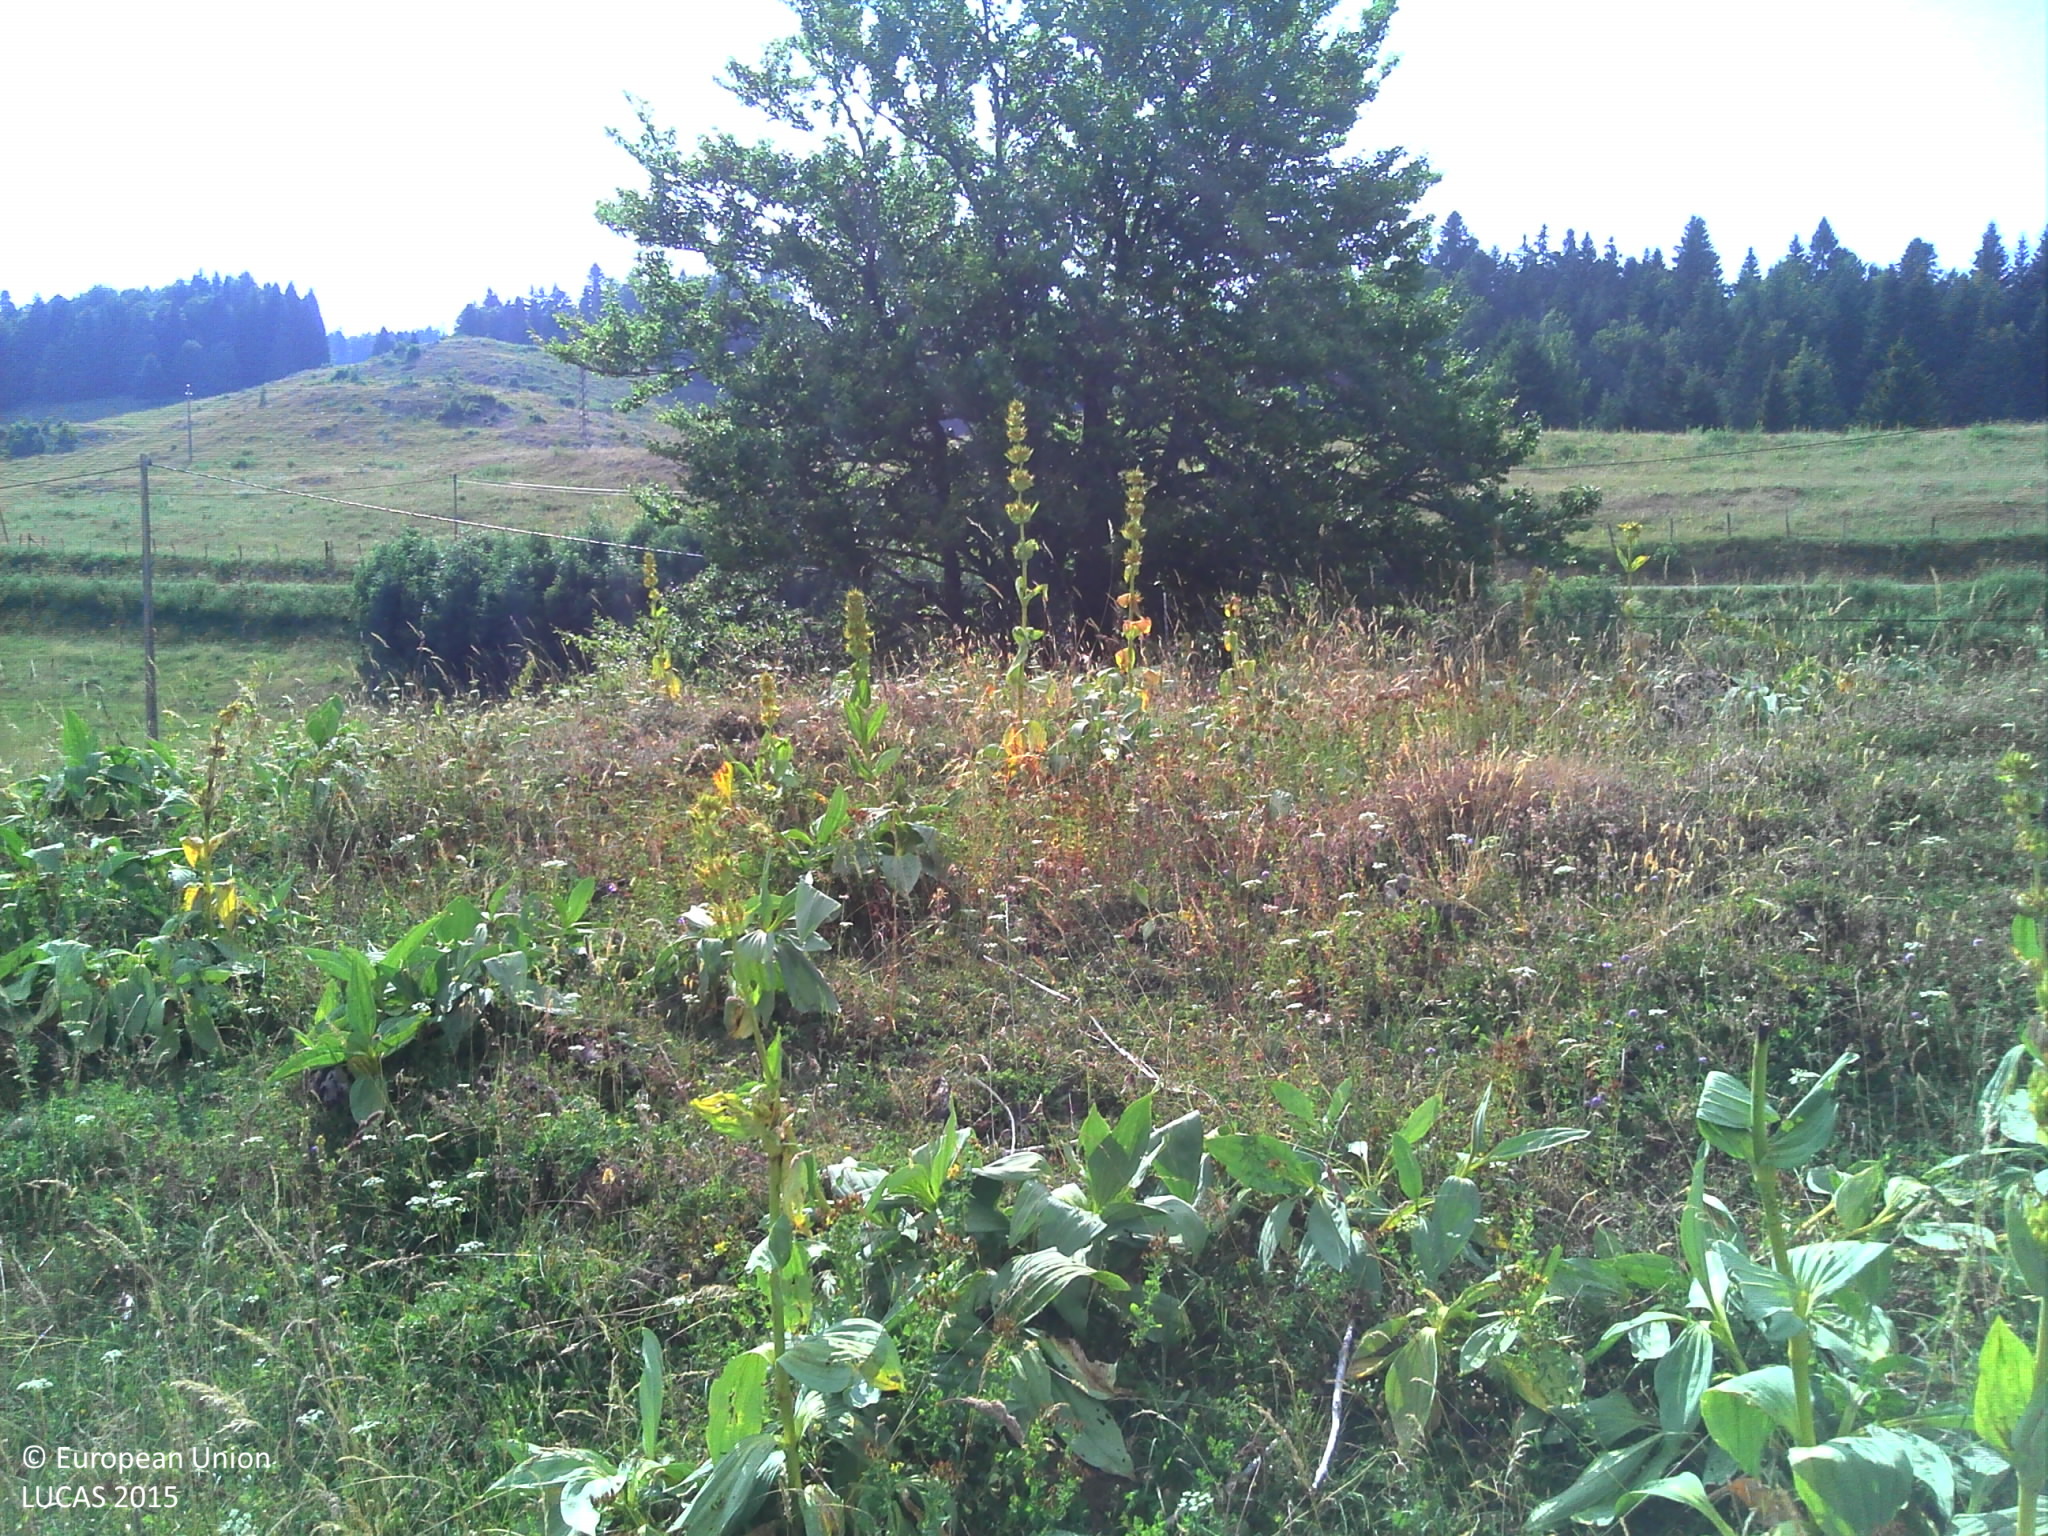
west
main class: Grassland
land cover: Grassland without tree/shrub cover
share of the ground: > 75 %
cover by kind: herbaceous plants 100 %
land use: Agriculture (excluding fallow land and kitchen gardens)
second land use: Sport
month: July
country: FR
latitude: 46.4419
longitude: 6.0851
